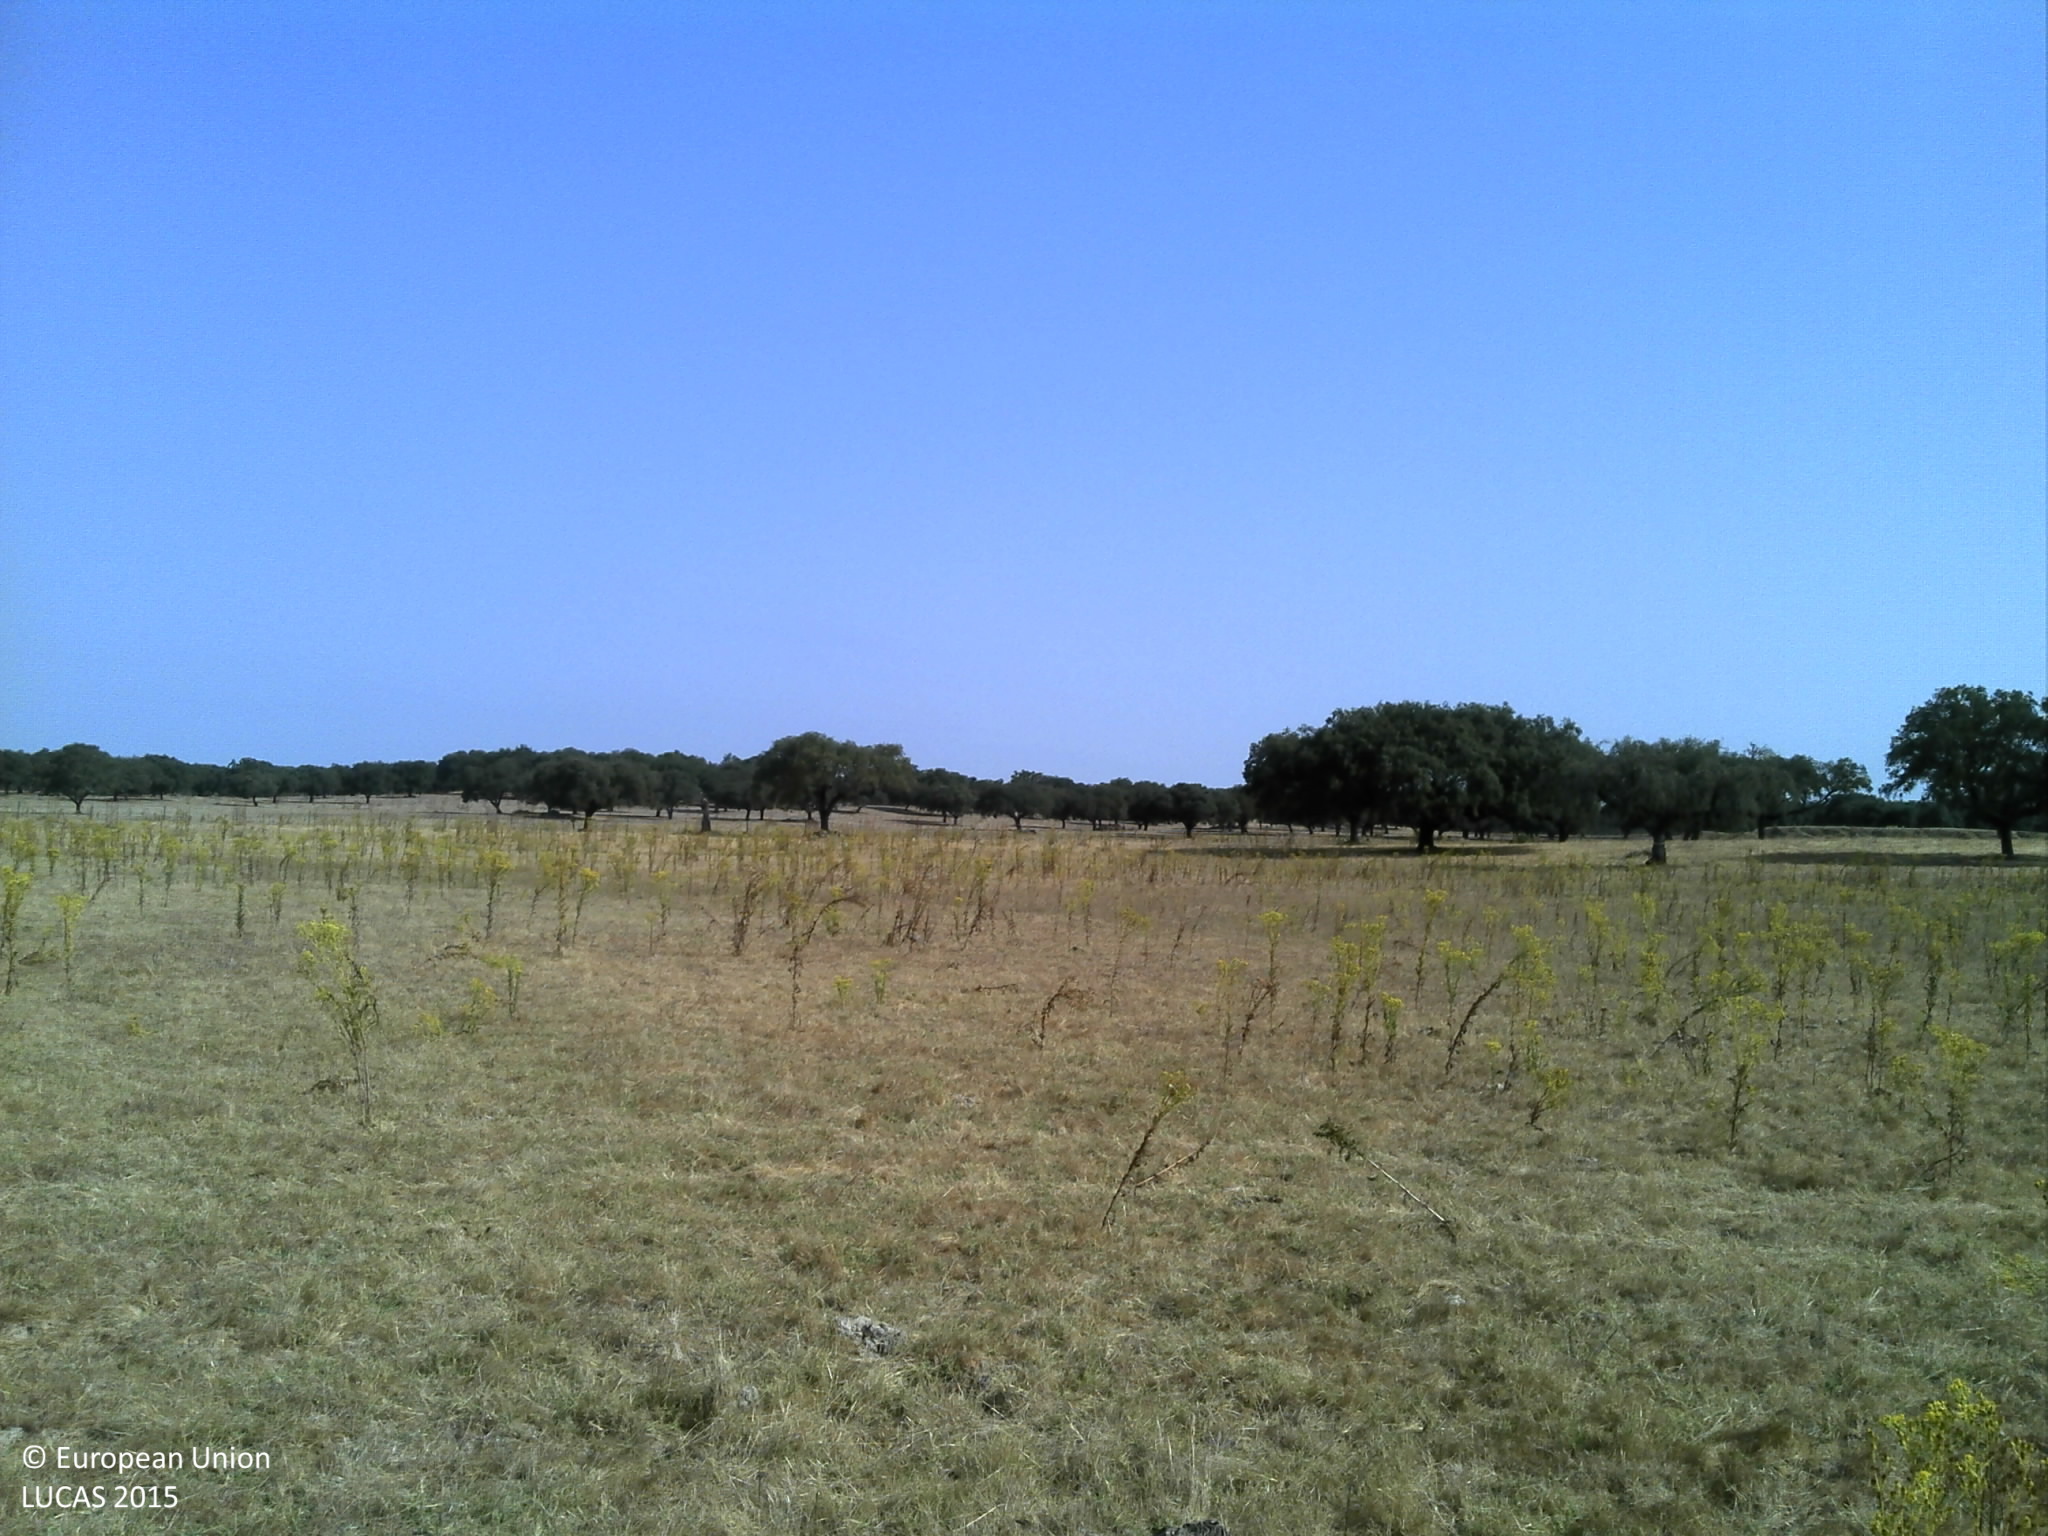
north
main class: Grassland
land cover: Grassland without tree/shrub cover
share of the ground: 50 - 75 %
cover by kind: herbaceous plants 60 %, unconsolidated bare surface 40 %
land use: Agriculture (excluding fallow land and kitchen gardens)
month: August
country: PT
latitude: 39.2964
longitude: -7.5651
